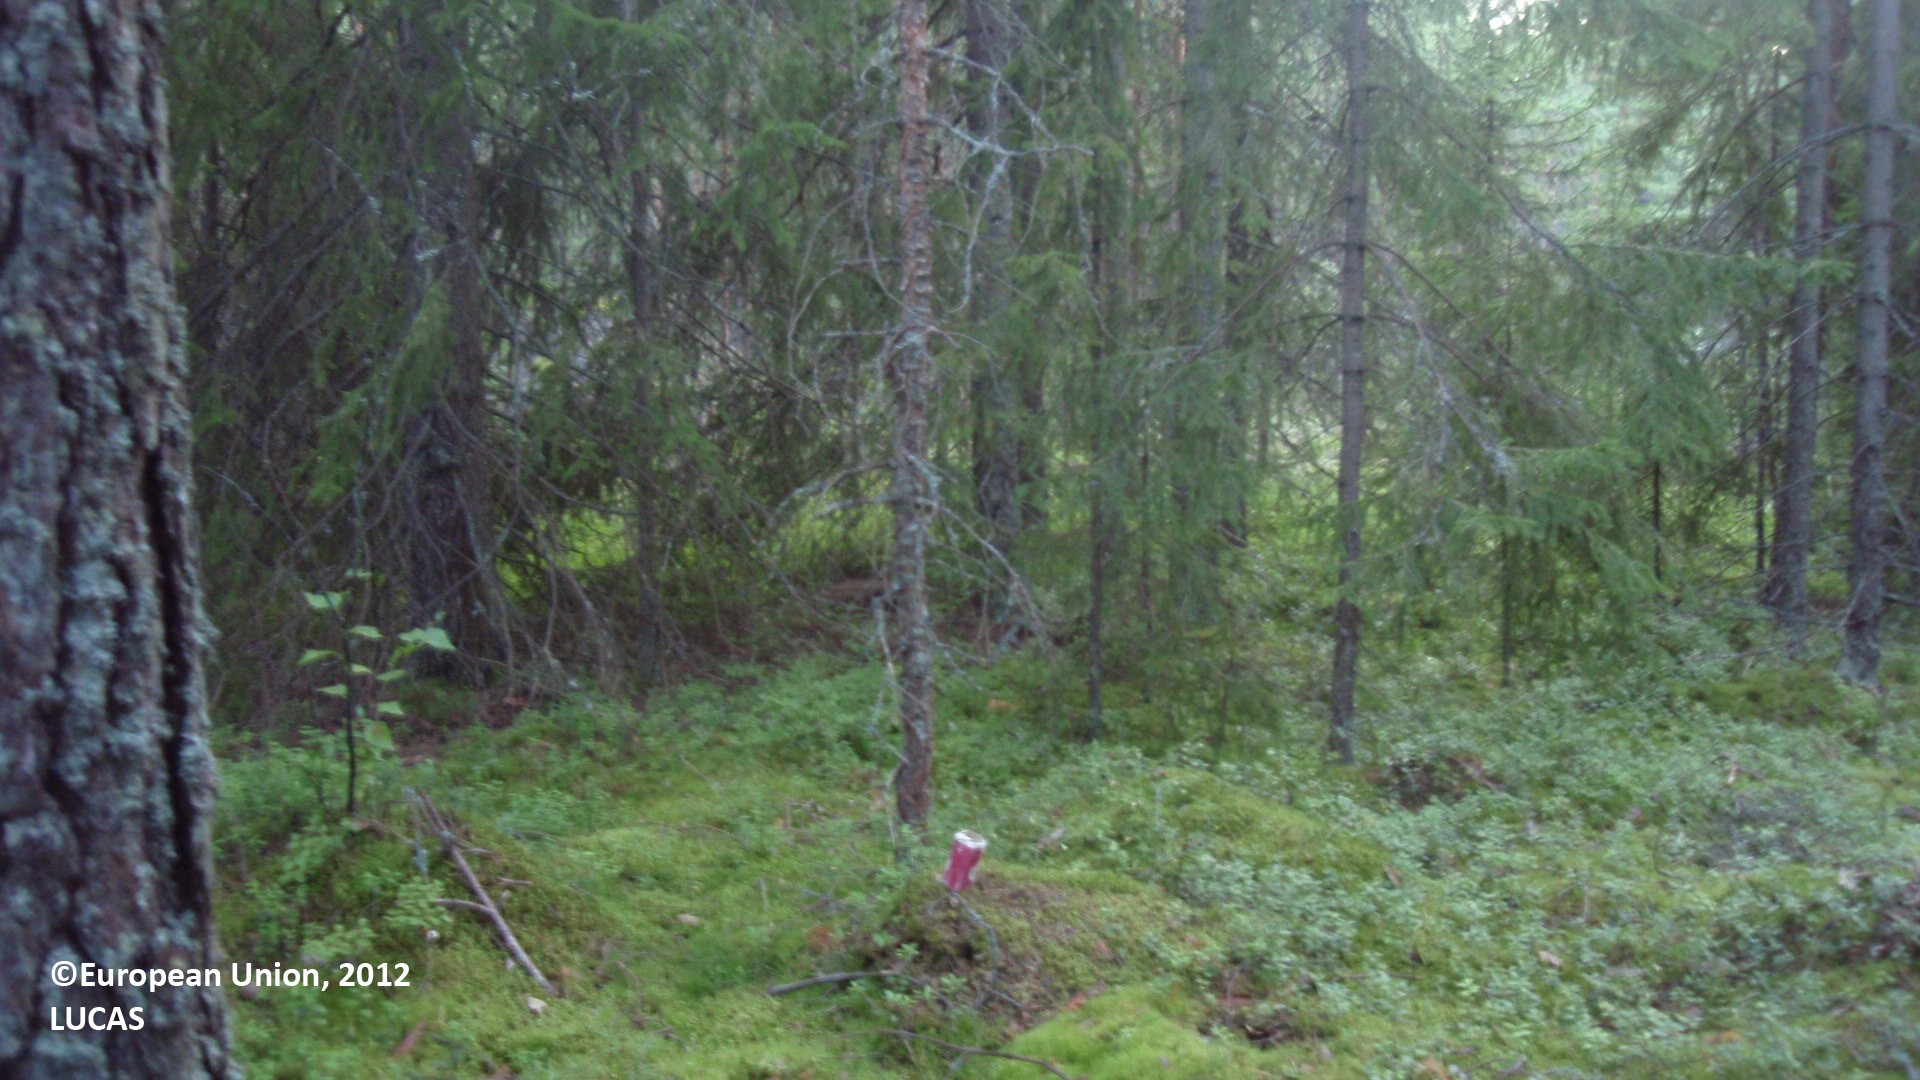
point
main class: Woodland
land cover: Spruce dominated mixed woodland
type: boreal forest
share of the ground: 50 - 75 %
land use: Forestry
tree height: > 5 m
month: August
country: FI
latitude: 60.5030
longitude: 27.4641
